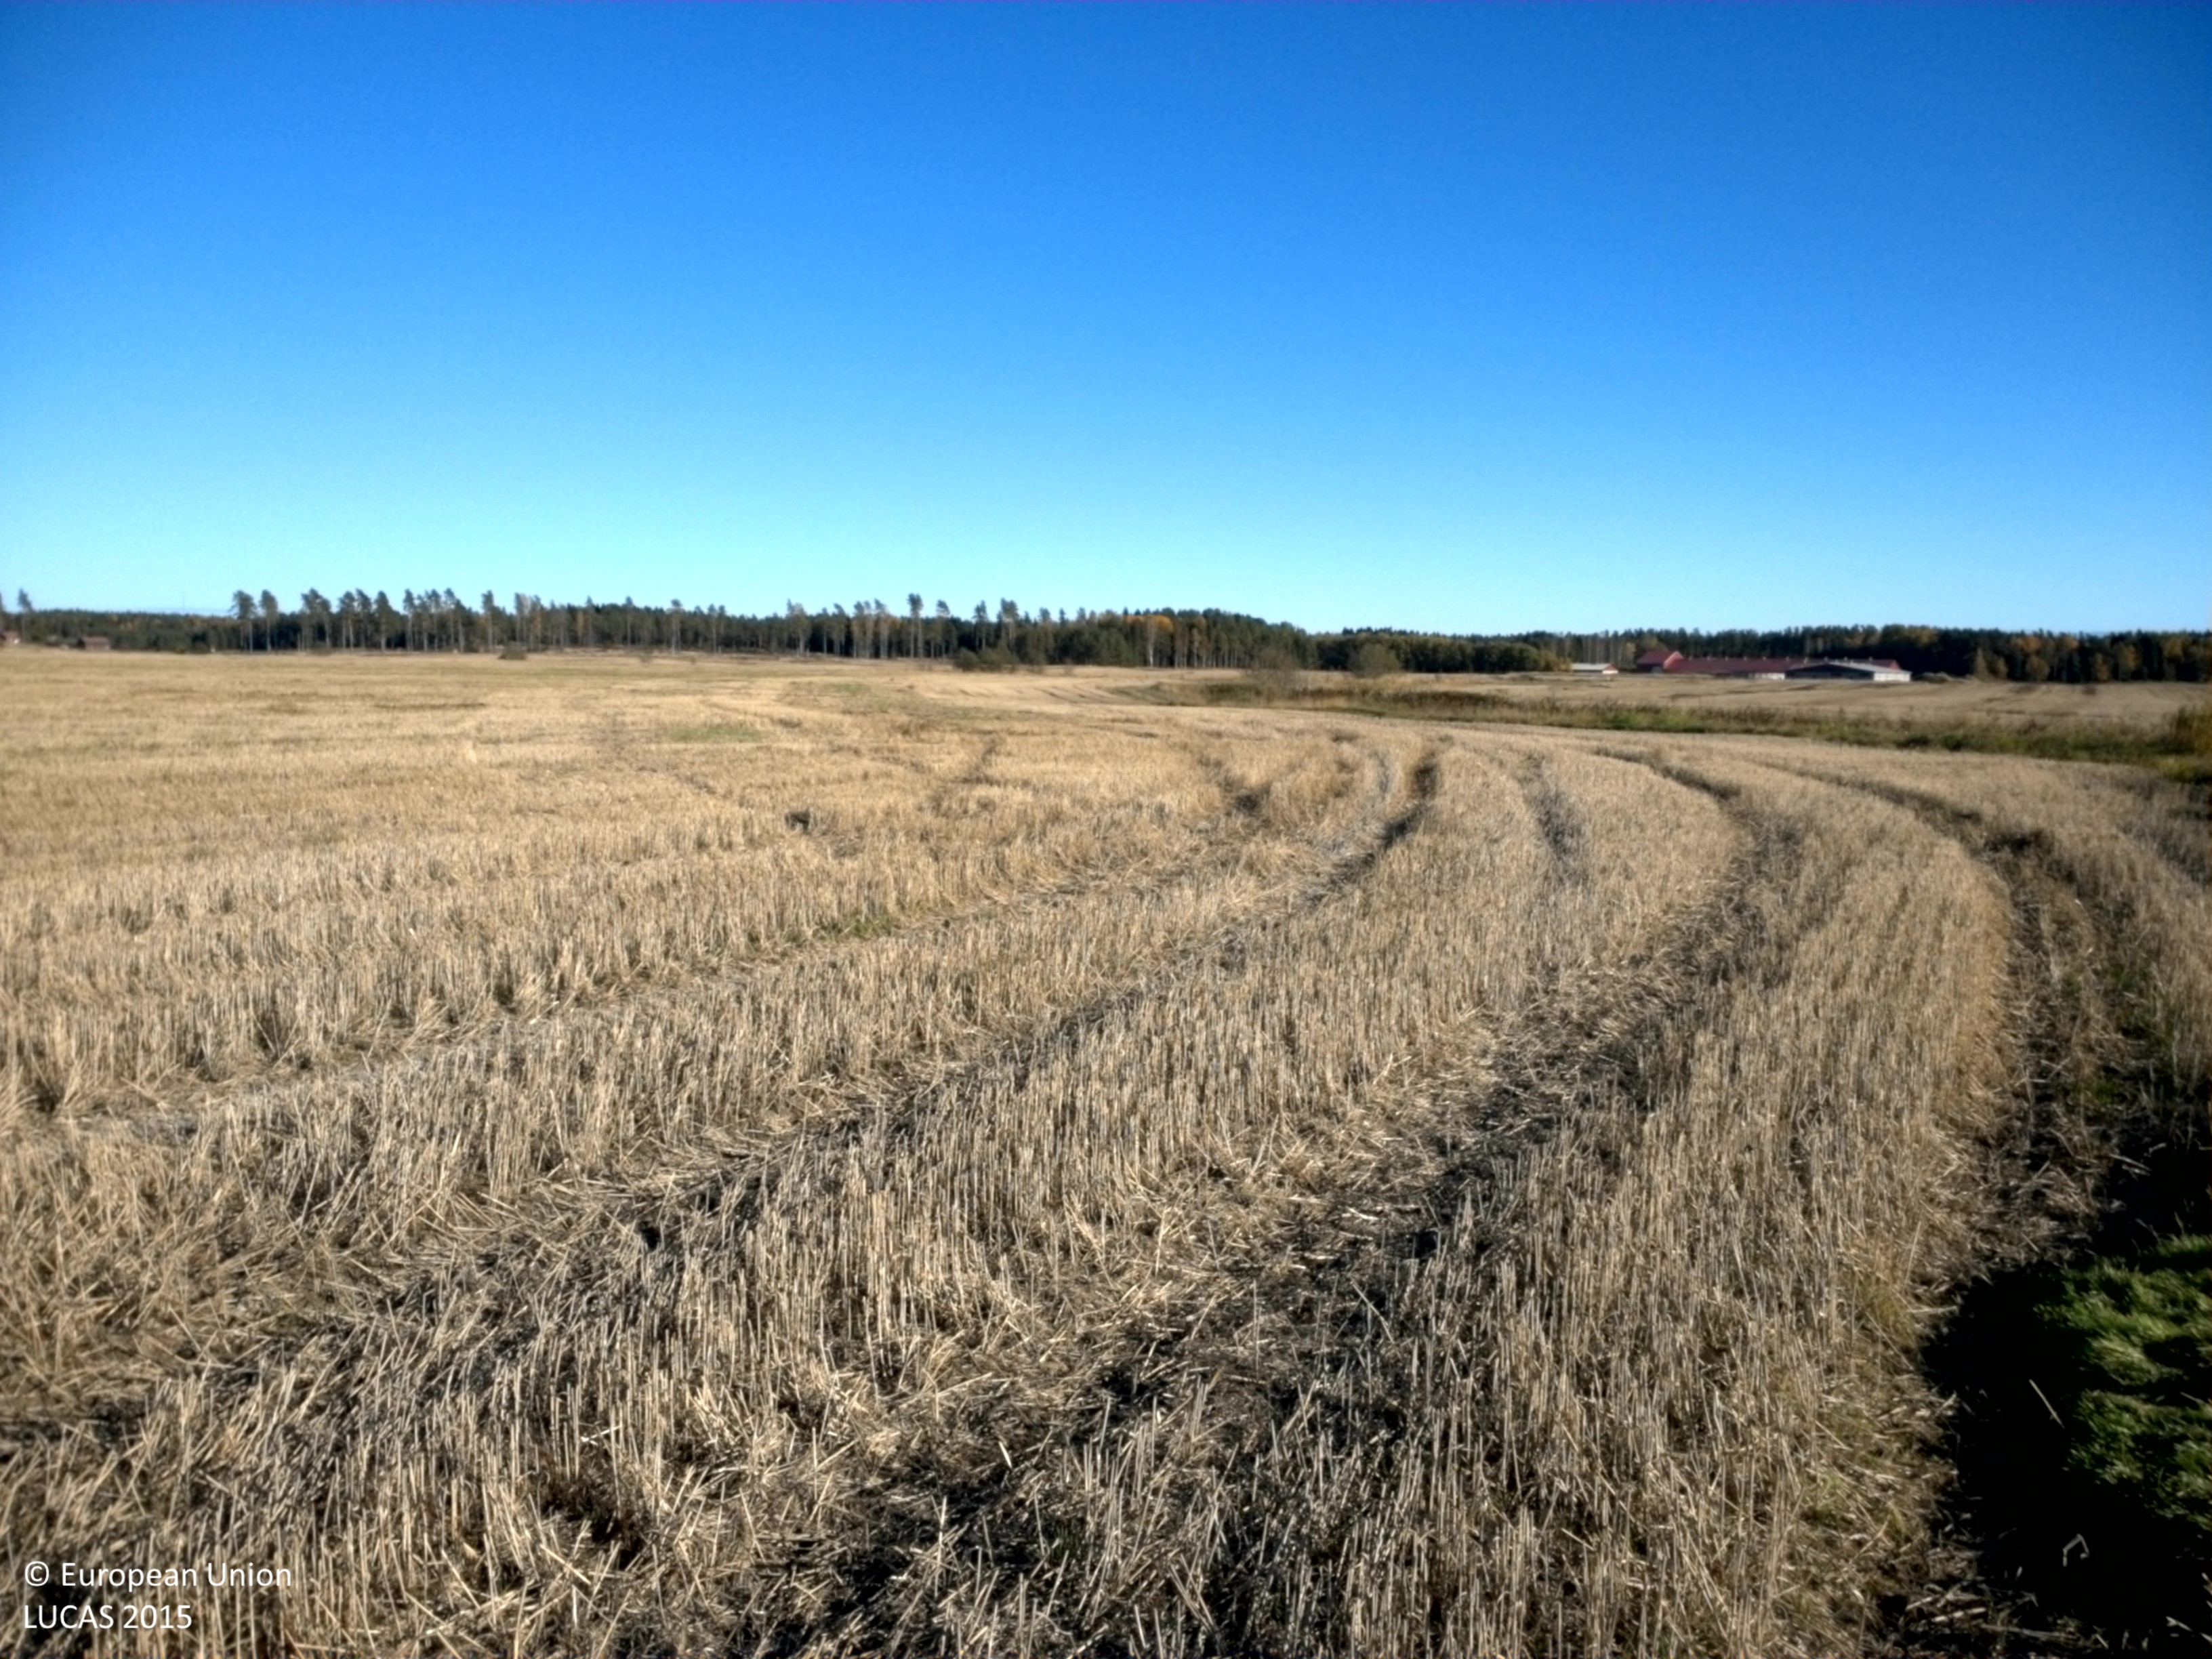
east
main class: Cropland
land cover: Common wheat
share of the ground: > 75 %
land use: Agriculture (excluding fallow land and kitchen gardens)
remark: Harvested field
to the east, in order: Common wheat
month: October
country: SE
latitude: 59.0656
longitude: 13.1151
